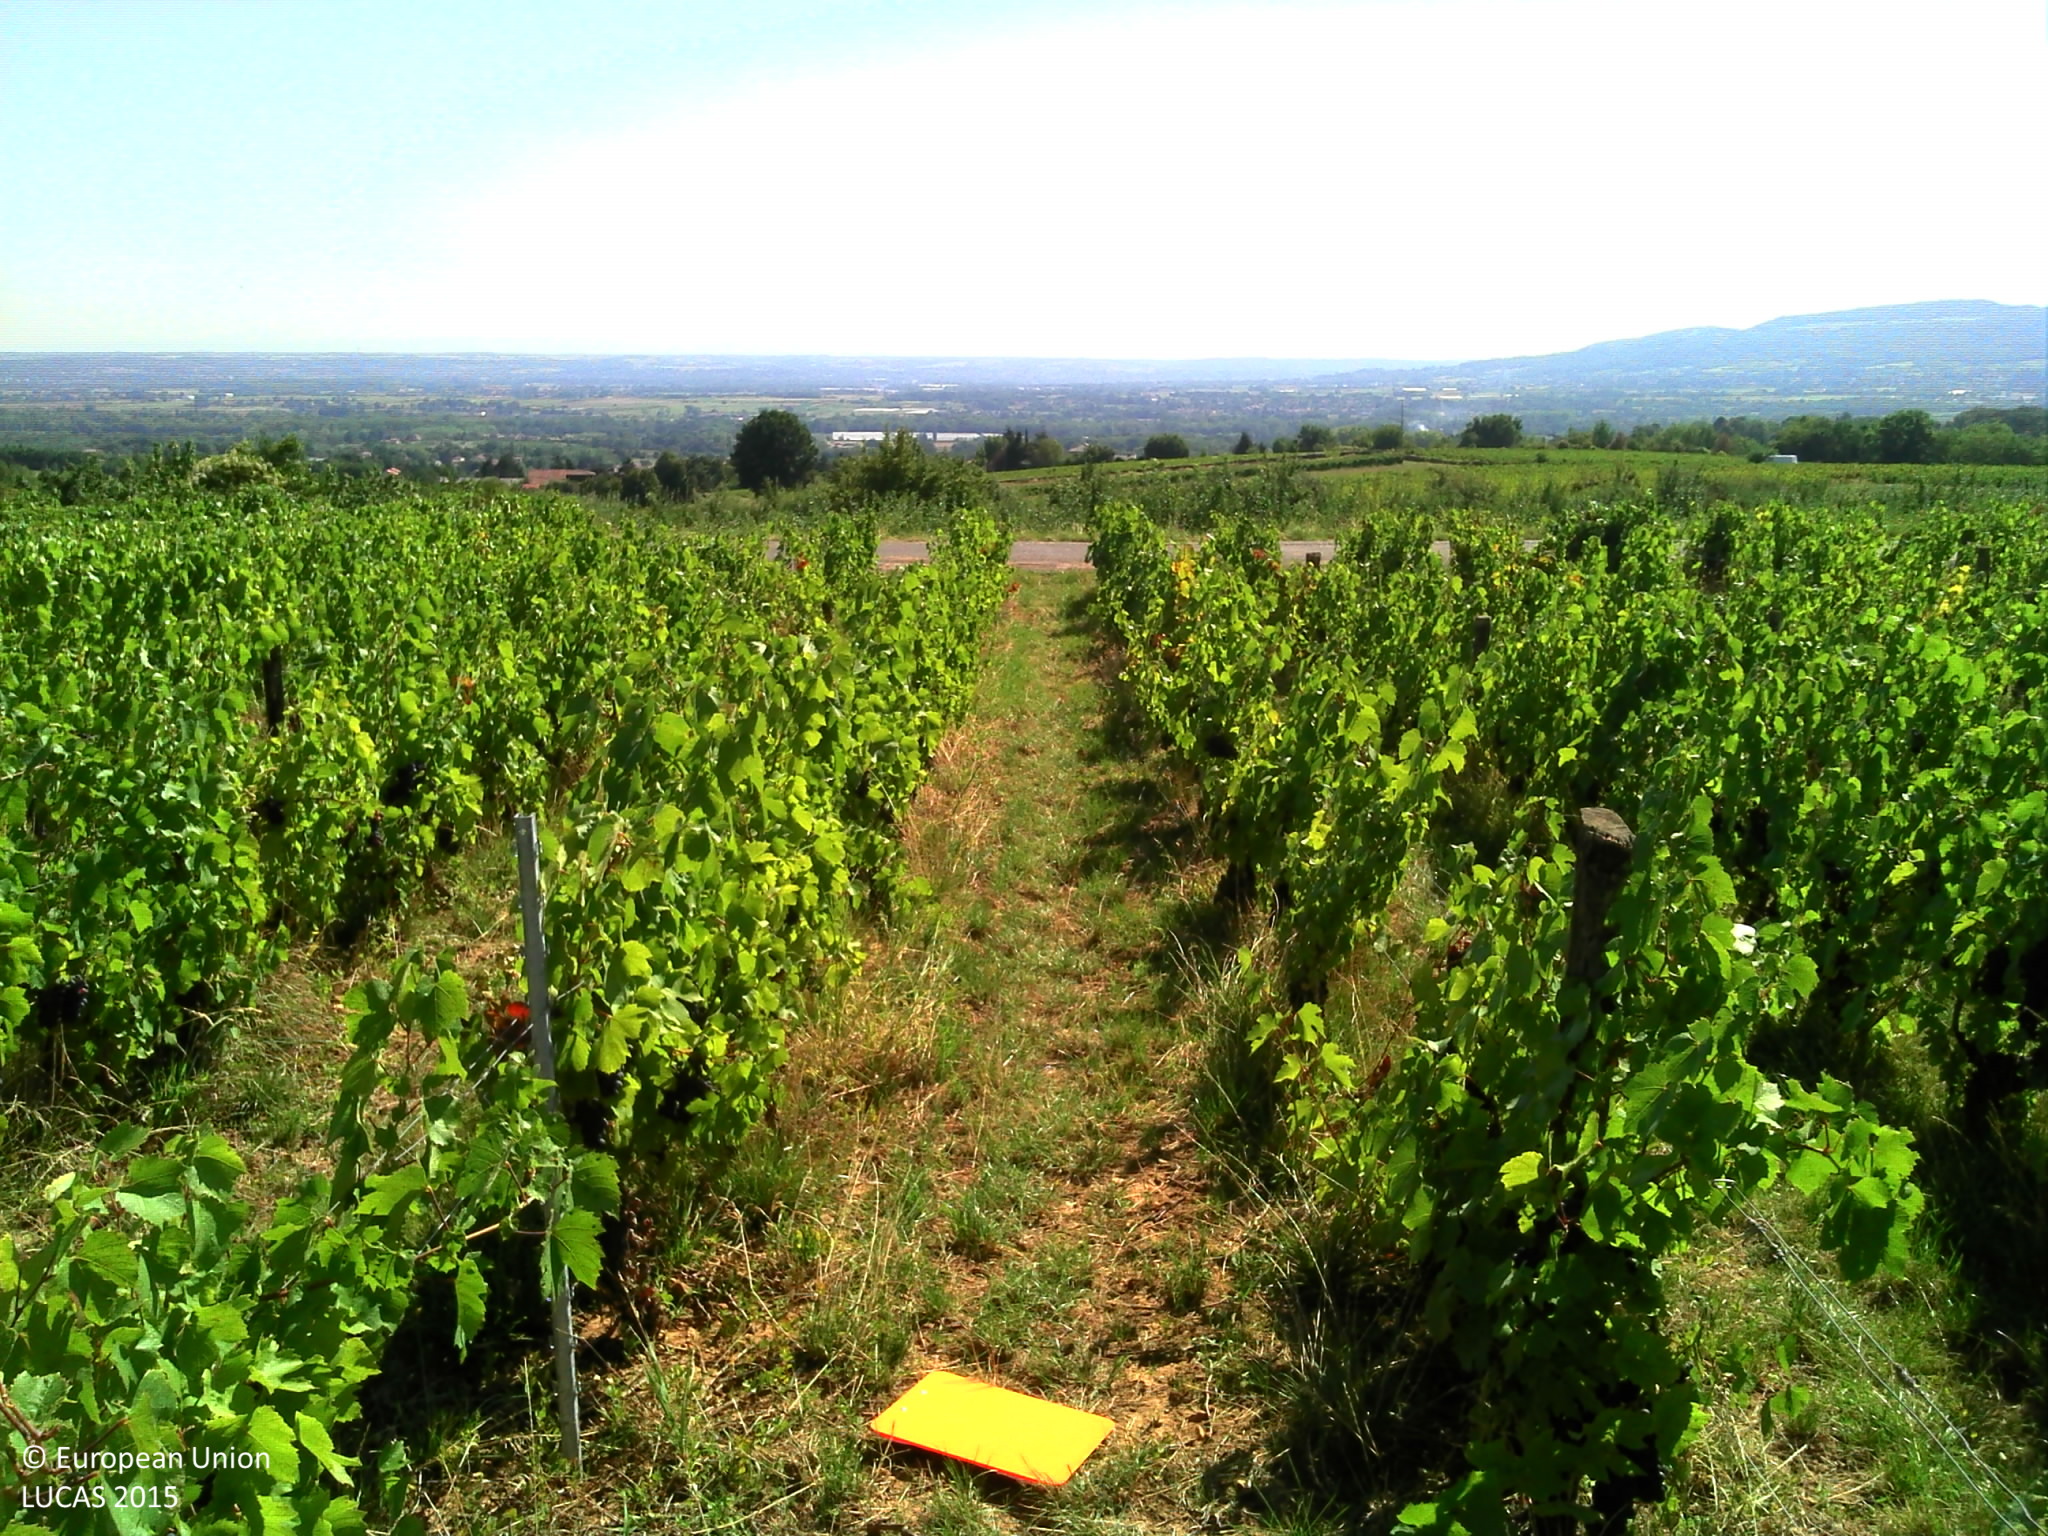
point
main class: Cropland
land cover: Vineyards
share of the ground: 50 - 75 %
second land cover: Grassland without tree/shrub cover
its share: 25 - 50 %
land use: Agriculture (excluding fallow land and kitchen gardens)
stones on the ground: 10 - 25 %
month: August
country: FR
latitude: 45.8939
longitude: 4.6804
